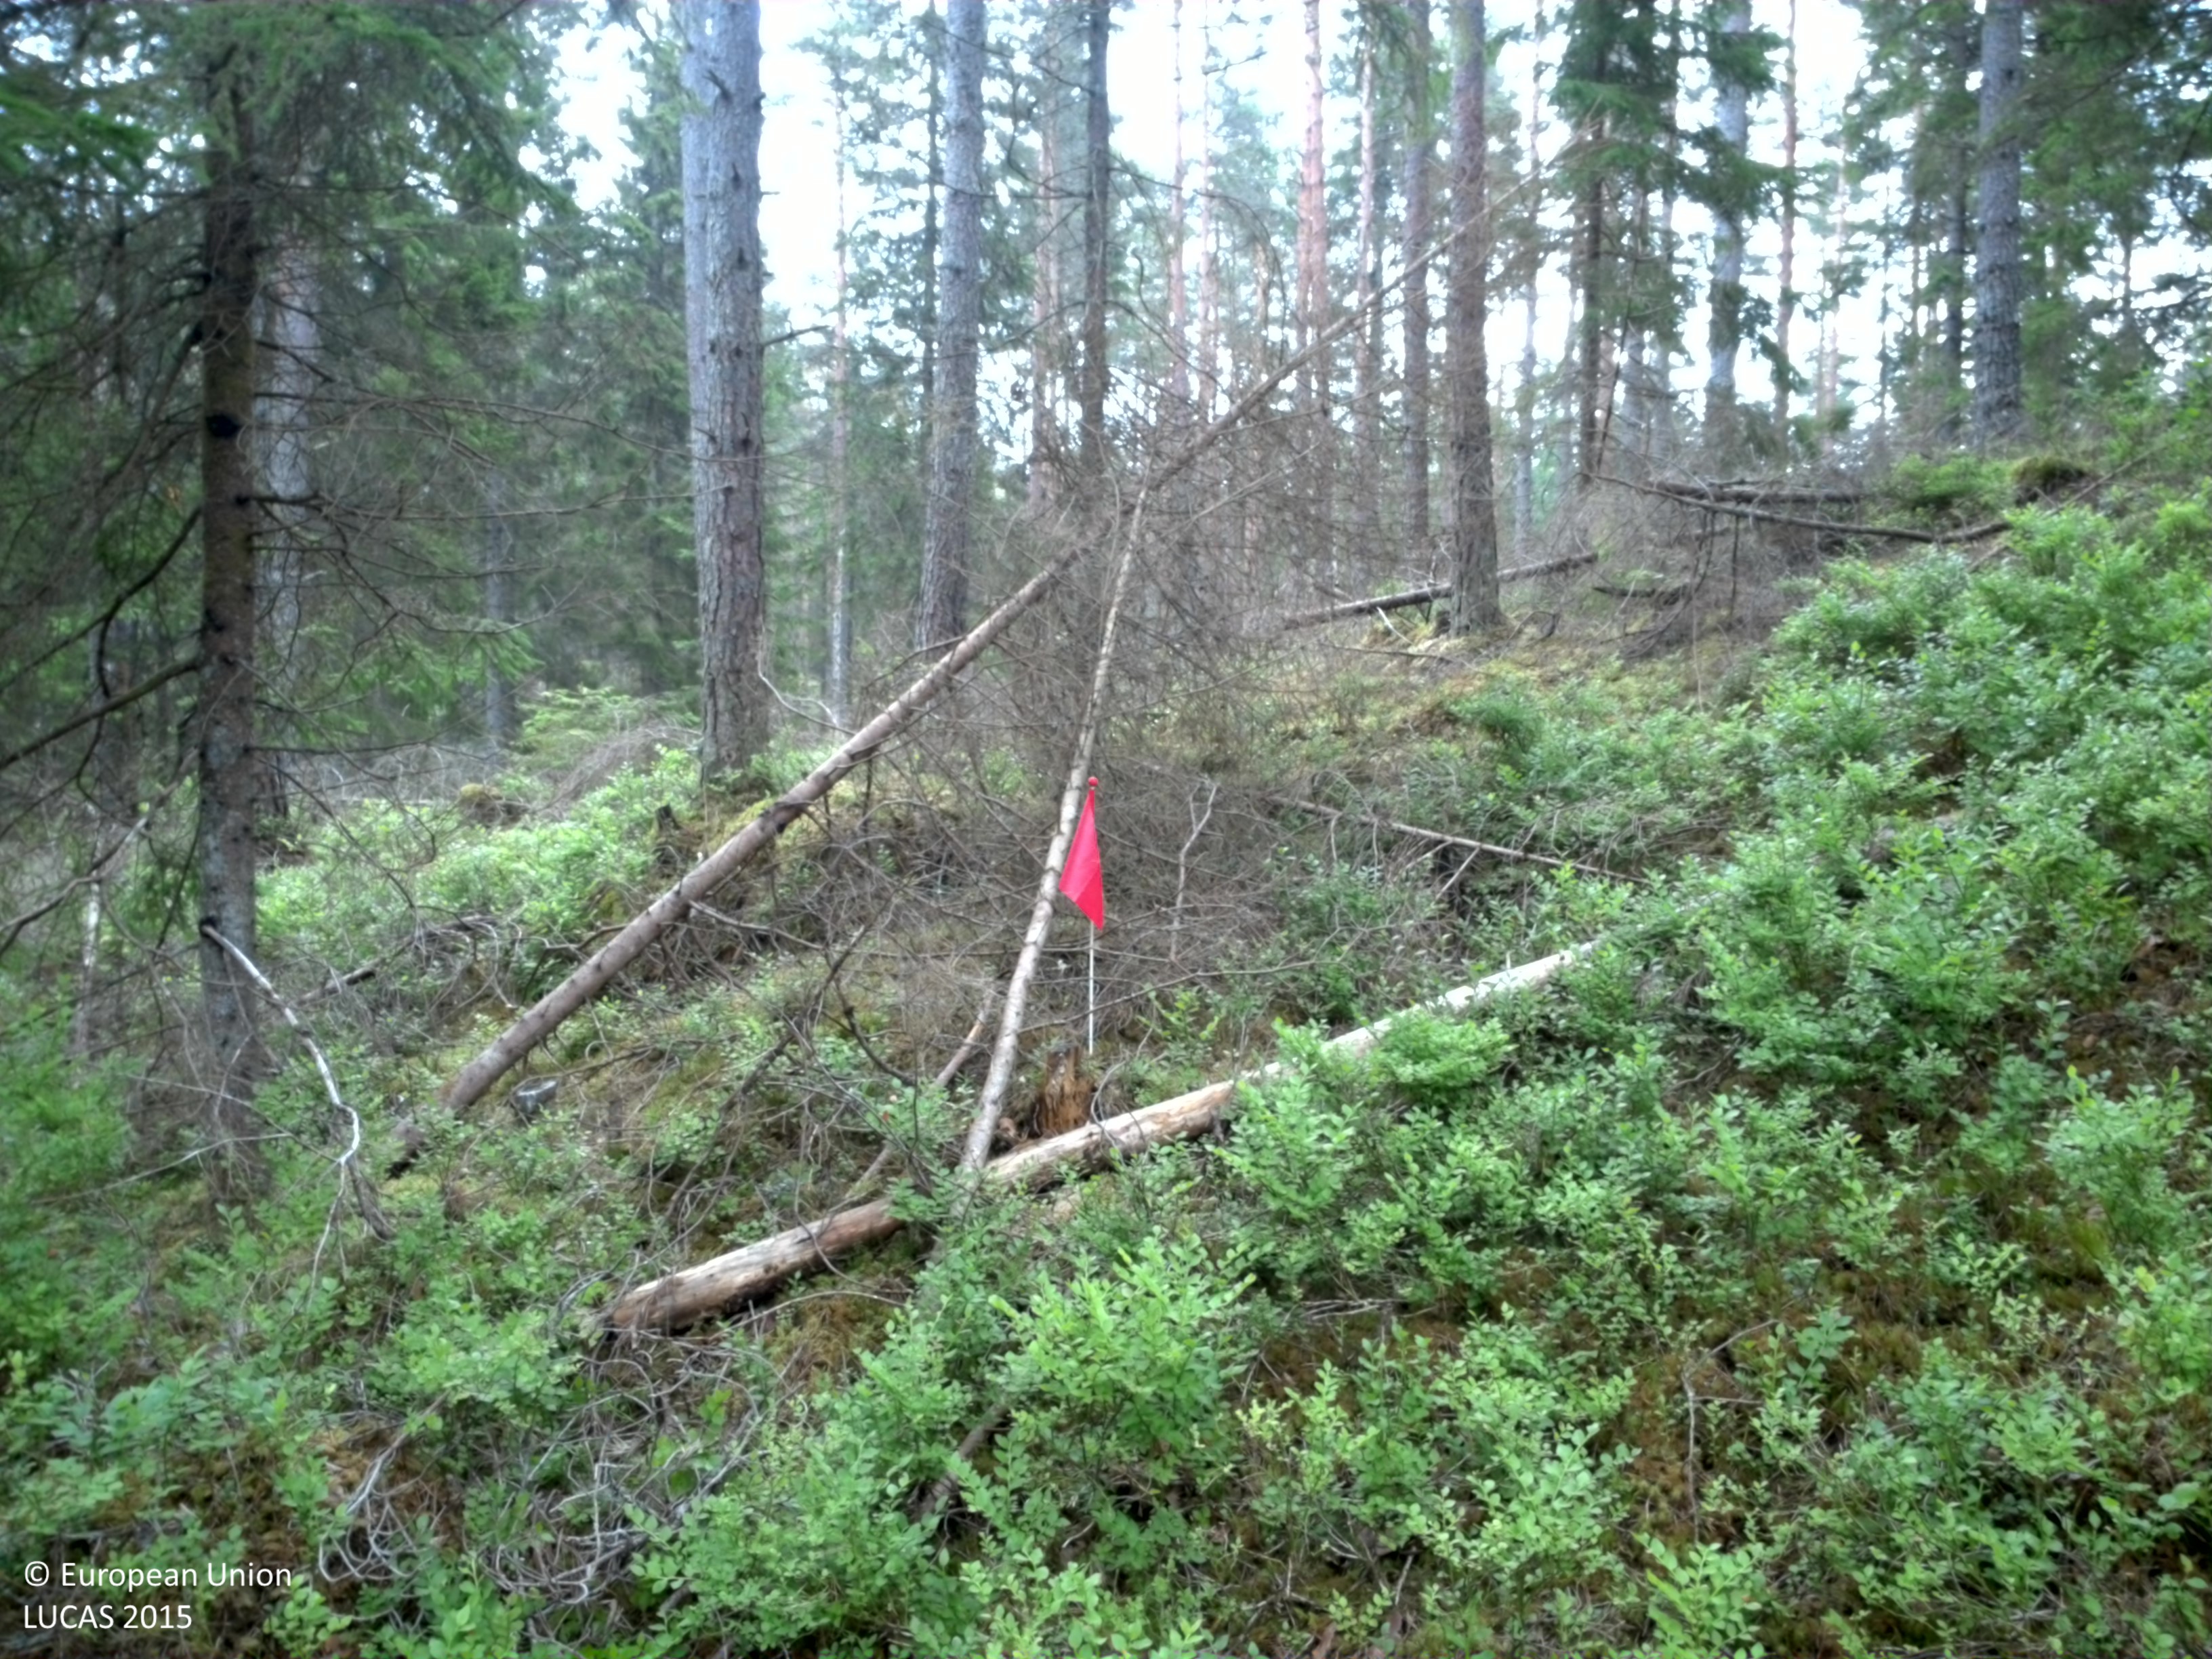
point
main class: Woodland
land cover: Pine dominated coniferous woodland
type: boreal forest
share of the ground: 50 - 75 %
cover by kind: coniferous forest trees 60 %, shrubs 35 %, lichens and mosses 5 %
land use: Forestry
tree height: > 5 m
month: July
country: SE
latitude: 58.7982
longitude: 14.3367
